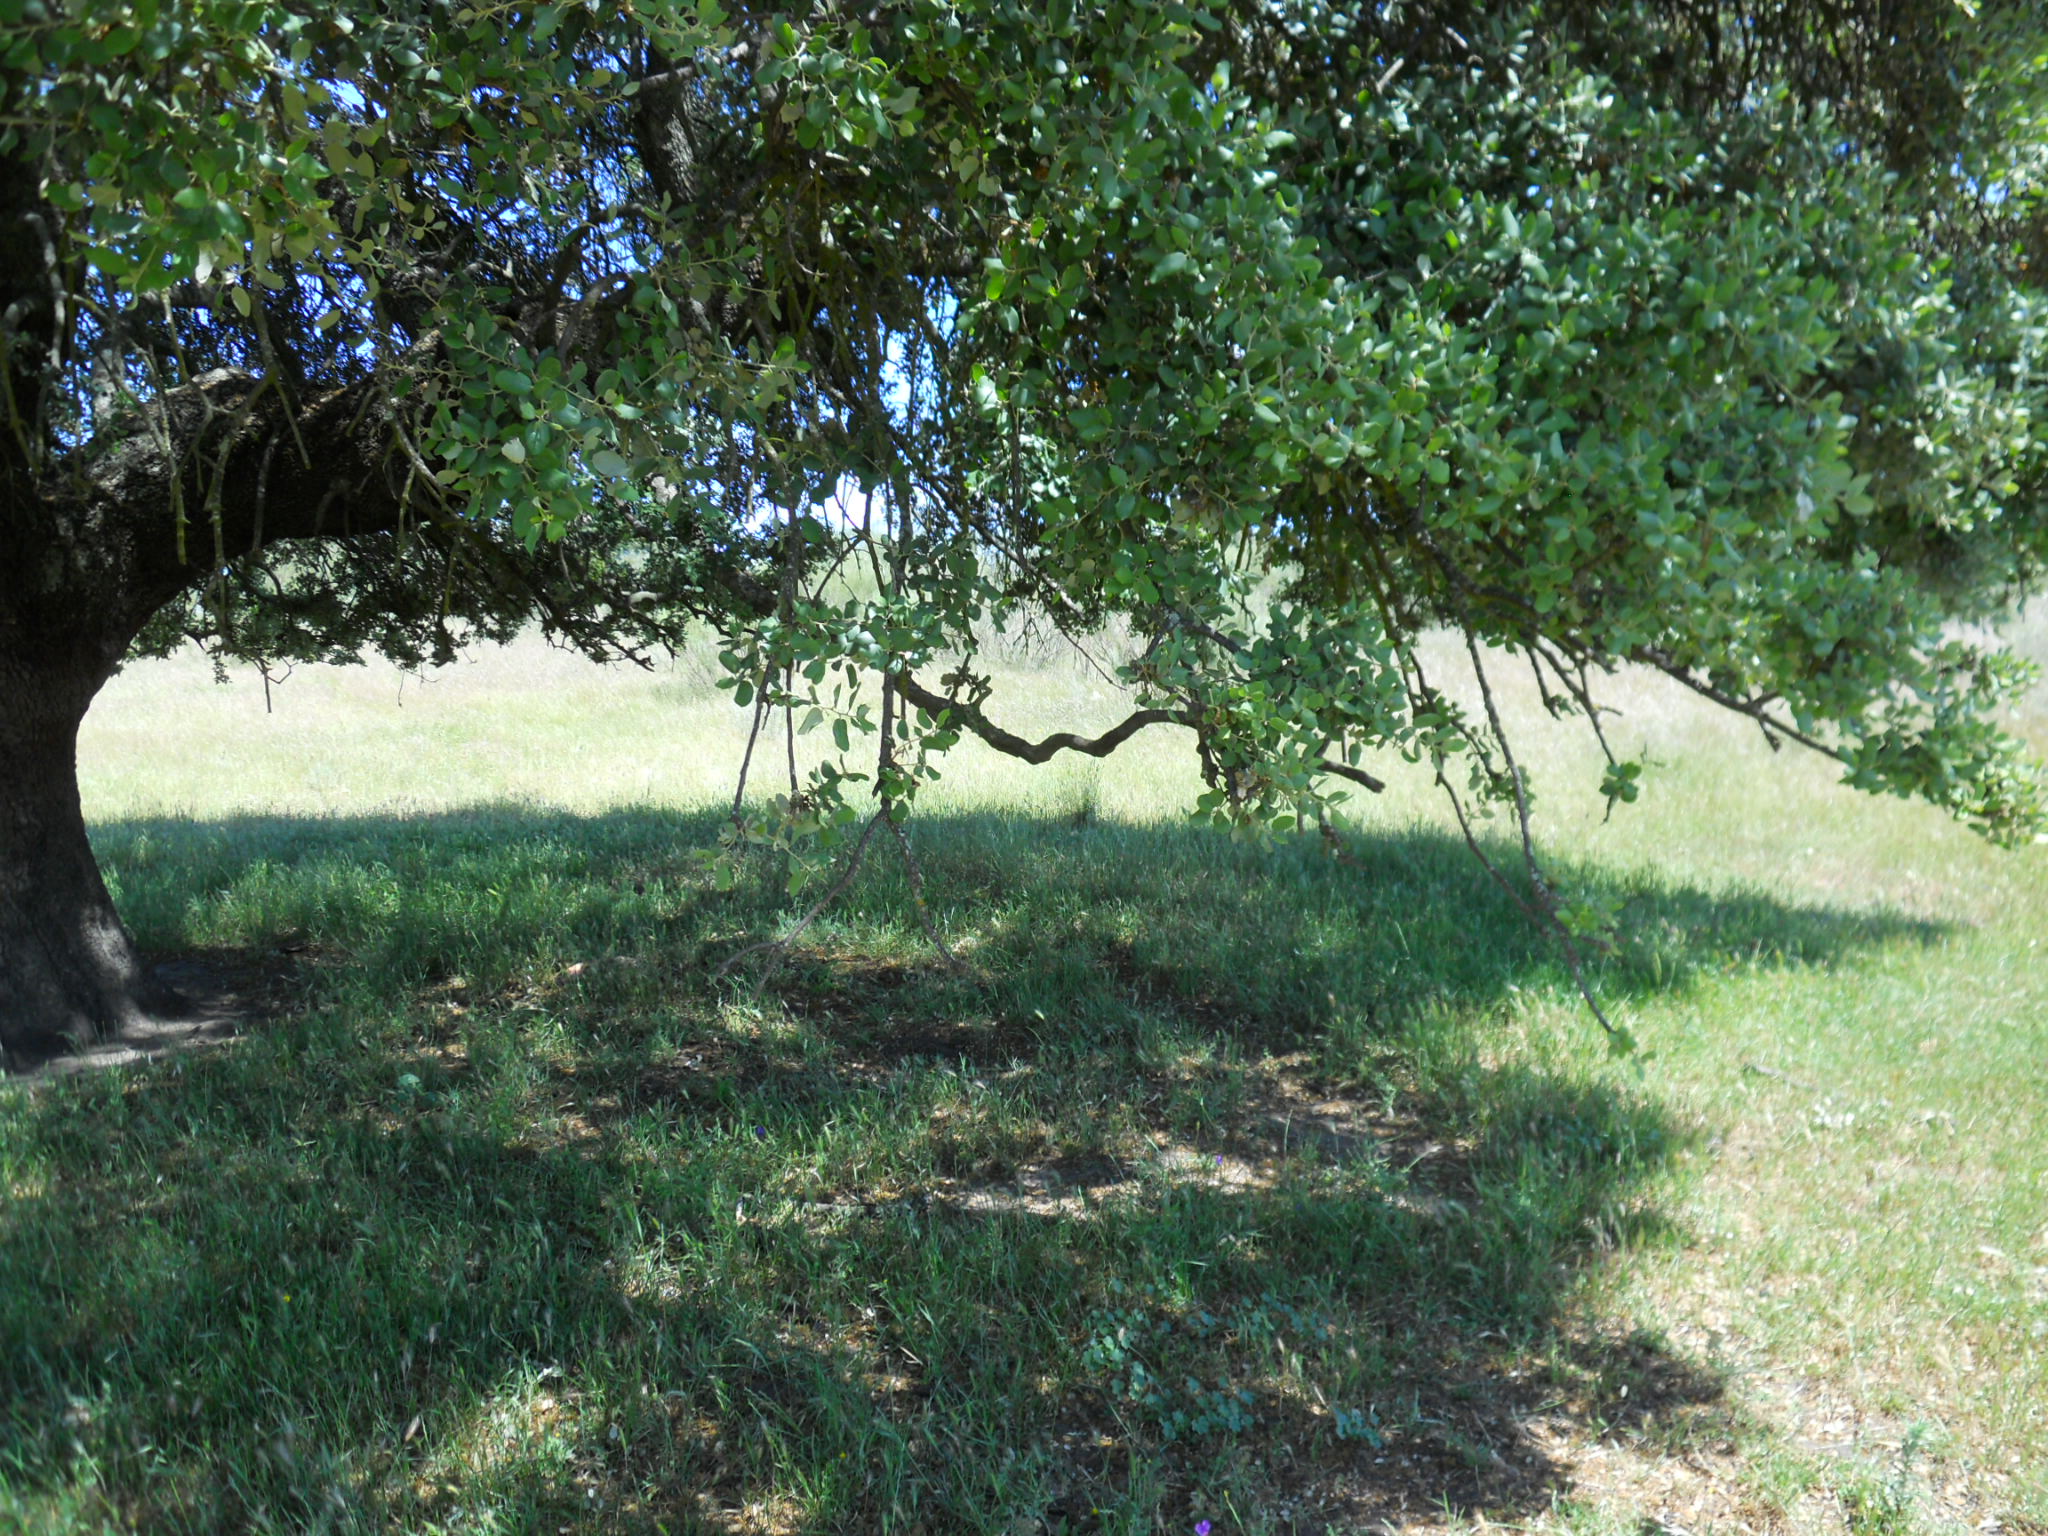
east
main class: Grassland
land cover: Grassland with sparse tree/shrub cover
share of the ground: > 75 %
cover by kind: herbaceous plants 95 %, broadleaved forest trees 5 %
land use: Agriculture (excluding fallow land and kitchen gardens)
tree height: > 5 m
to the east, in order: Grassland with sparse tree/shrub cover; Shrubland with sparse tree cover; Grassland with sparse tree/shrub cover
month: May
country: ES
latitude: 39.3113
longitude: -6.3359
